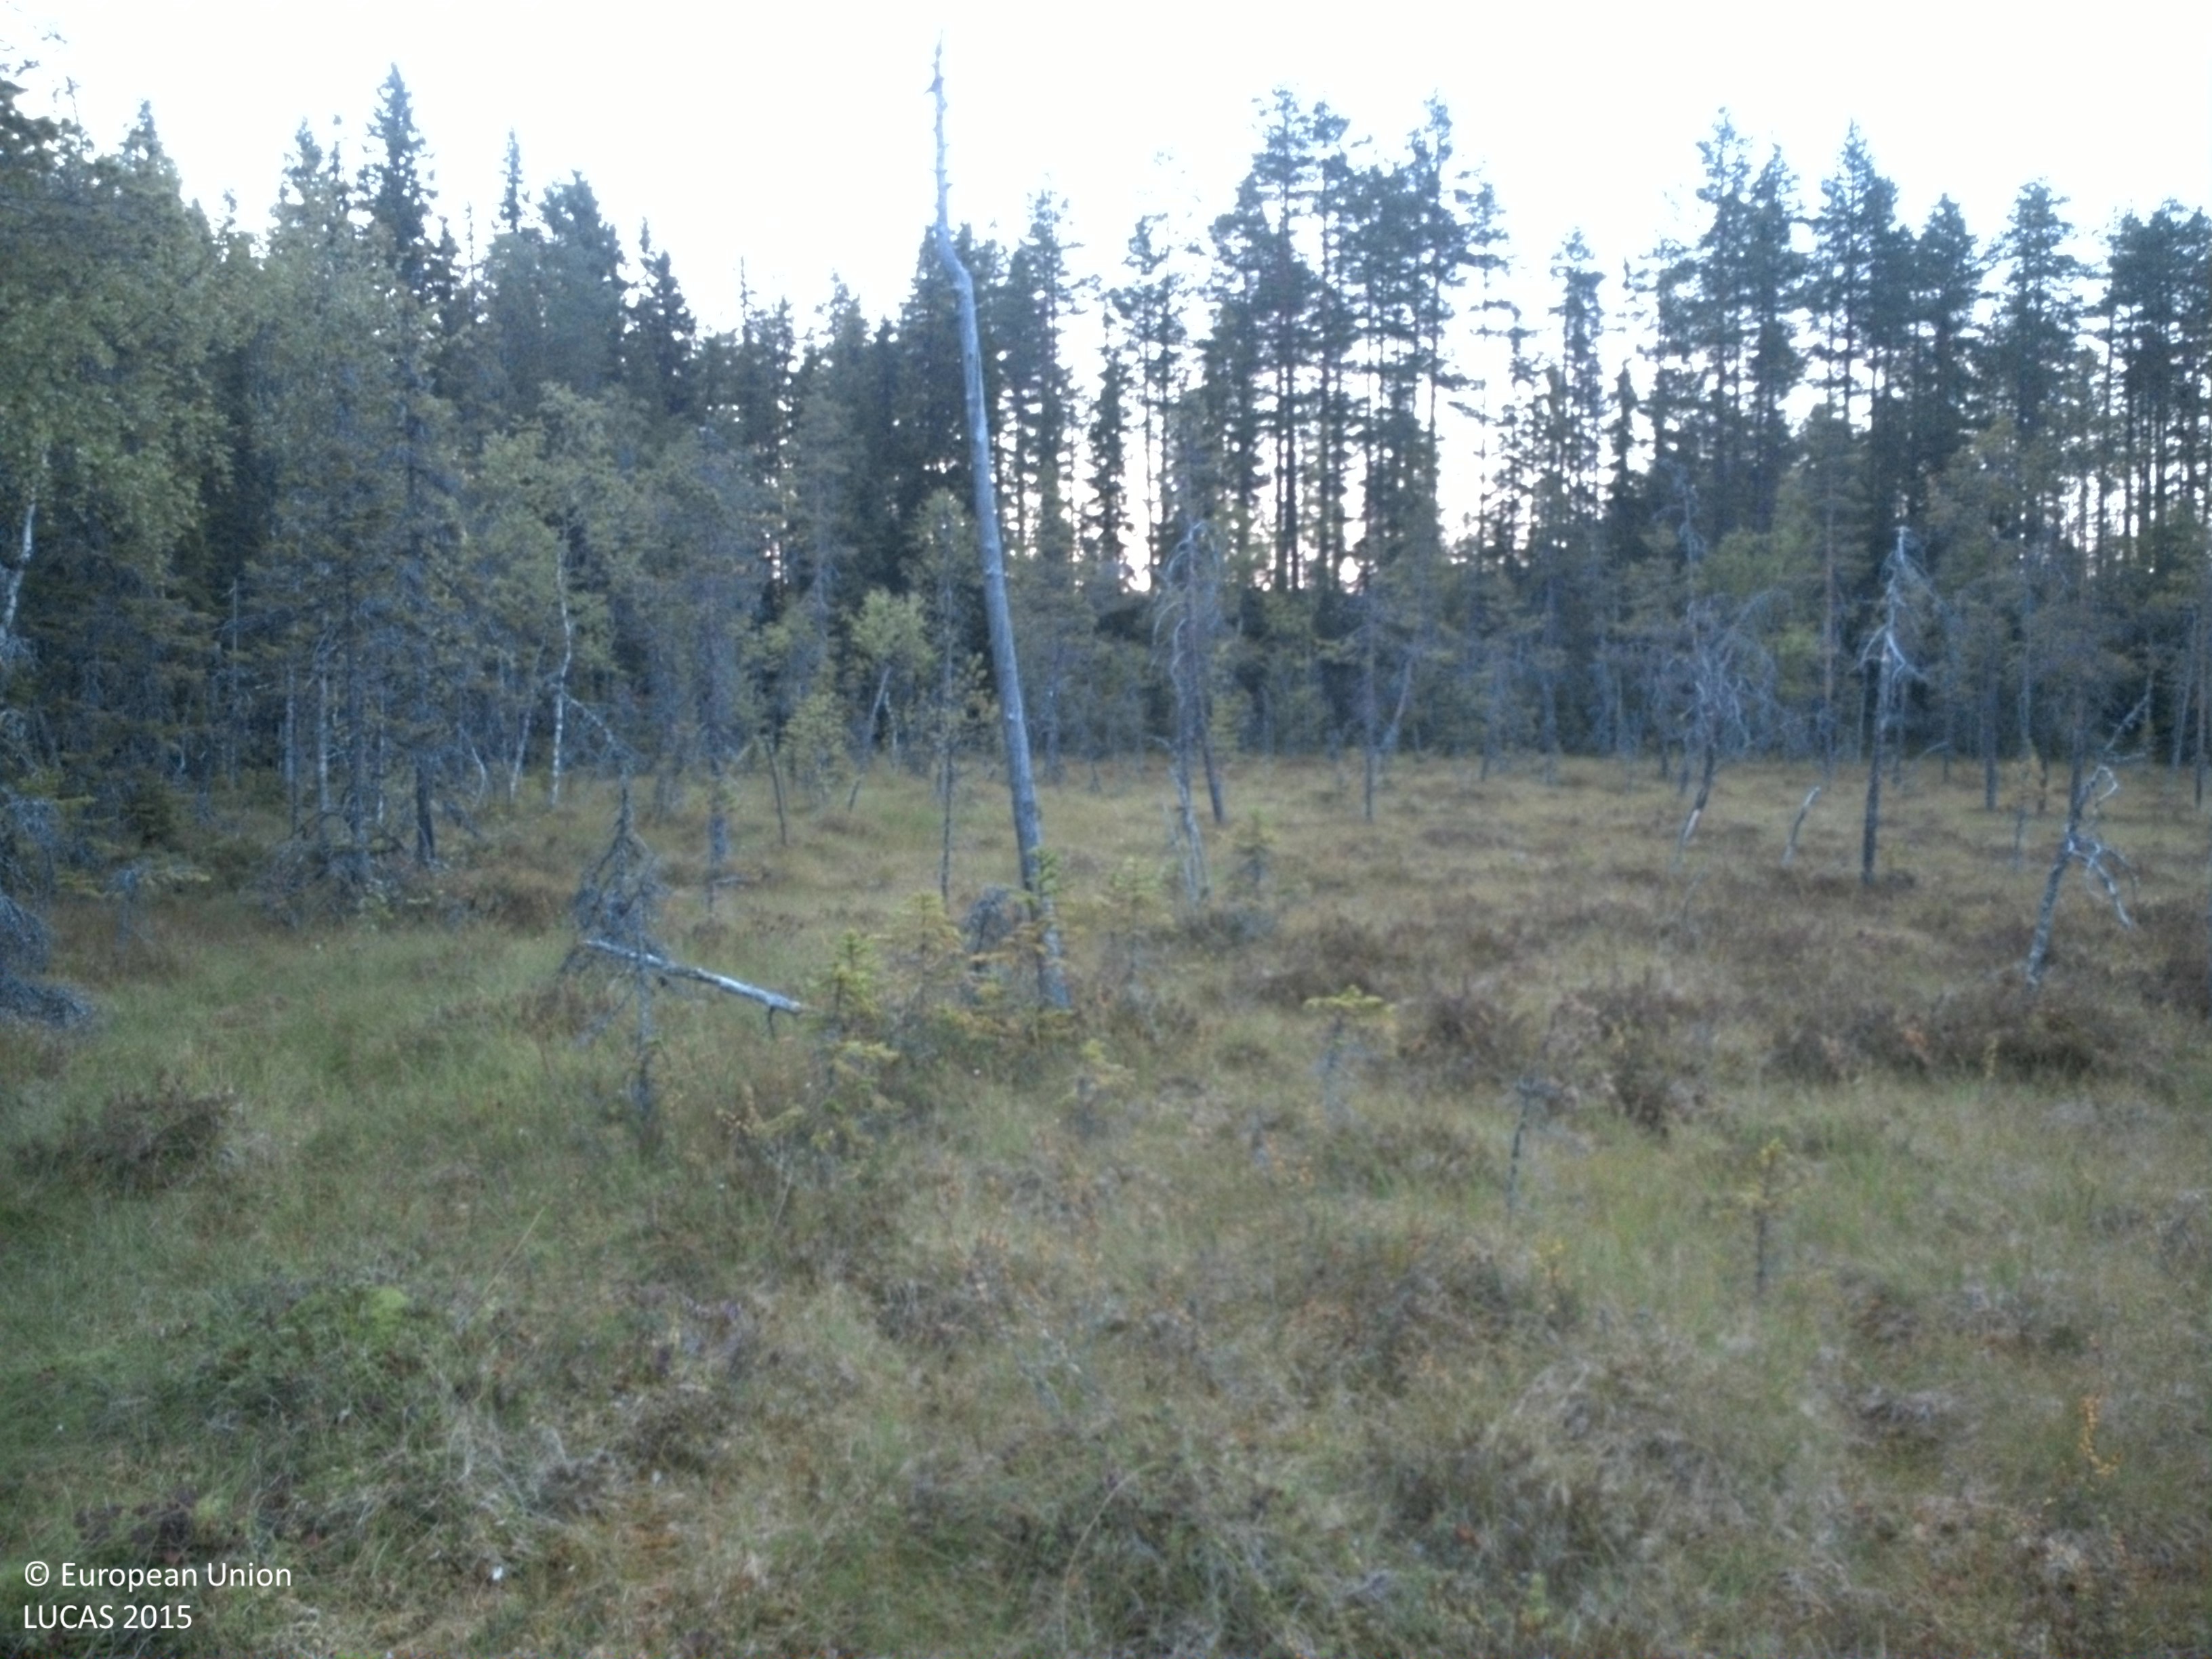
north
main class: Woodland
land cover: Other mixed woodland
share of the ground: 25 - 50 %
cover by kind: shrubs 25 %, lichens and mosses 25 %, coniferous forest trees 20 %, broadleaved forest trees 15 %, herbaceous plants 15 %
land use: Forestry
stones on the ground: < 10 %
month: August
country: SE
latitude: 61.7793
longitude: 15.2720
